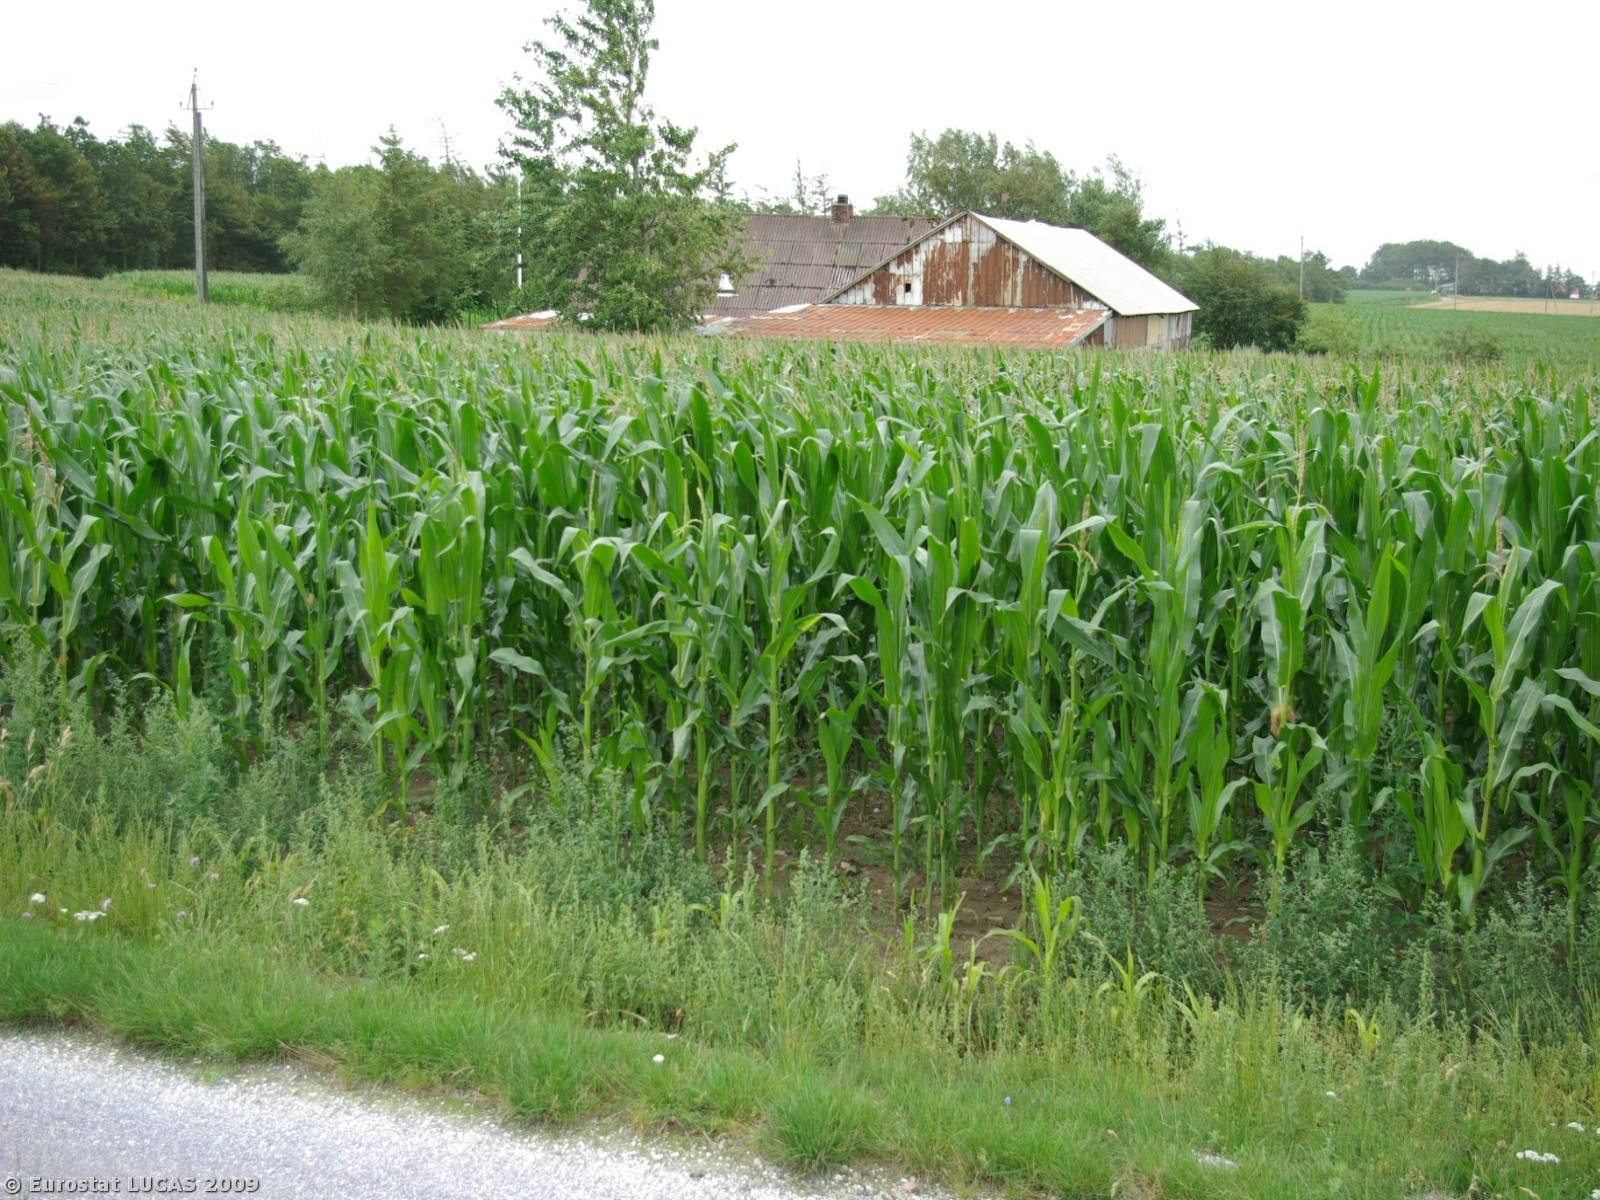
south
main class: Cropland
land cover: Maize
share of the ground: > 75 %
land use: Agriculture (excluding fallow land and kitchen gardens)
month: July
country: DK
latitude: 55.1223
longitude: 8.8876
